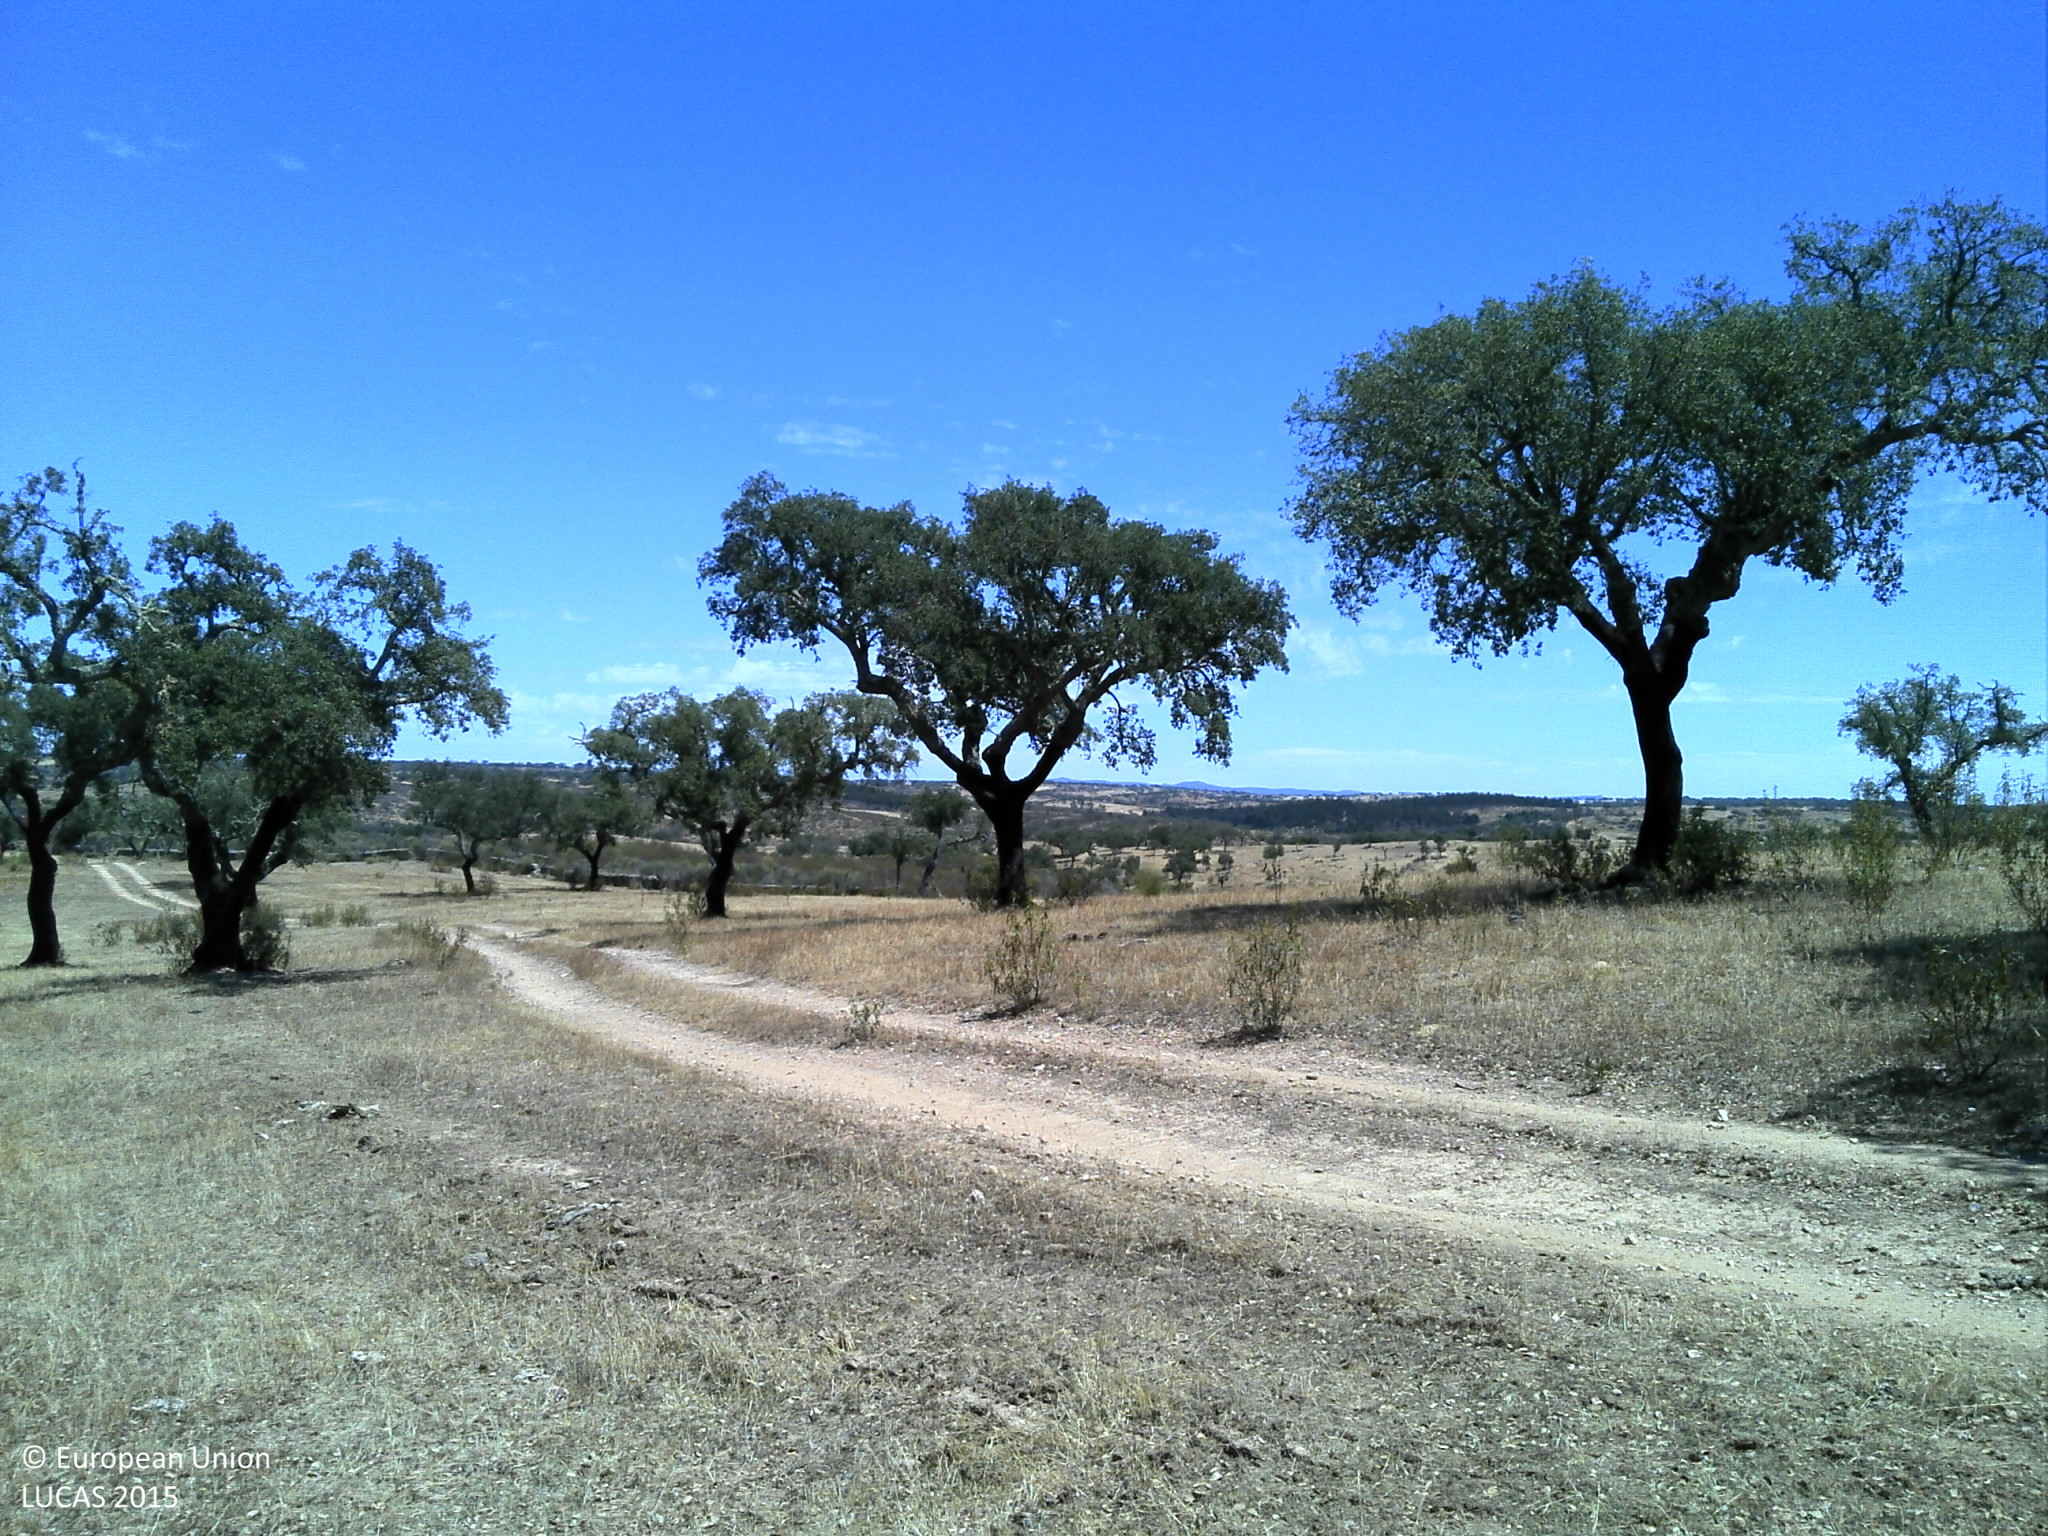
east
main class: Woodland
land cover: Broadleaved woodland
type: broadleaved evergreen forest
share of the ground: 10 - 25 %
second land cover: Grassland without tree/shrub cover
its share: 10 - 25 %
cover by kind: unconsolidated bare surface 80 %, broadleaved forest trees 10 %, herbaceous plants 10 %
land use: Forestry
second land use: Agriculture (excluding fallow land and kitchen gardens)
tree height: > 5 m
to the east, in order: Broadleaved woodland; Grassland without tree/shrub cover; Tracks; Broadleaved woodland; Grassland without tree/shrub cover; Fences; Dry stone walls; Shruby margins; Dry stone walls; Shrubland without tree cover; Tracks; Shrubland without tree cover; Grassland with sparse tree/shrub cover; Shrubland without tree cover
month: August
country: PT
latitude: 39.5549
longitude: -7.5647
